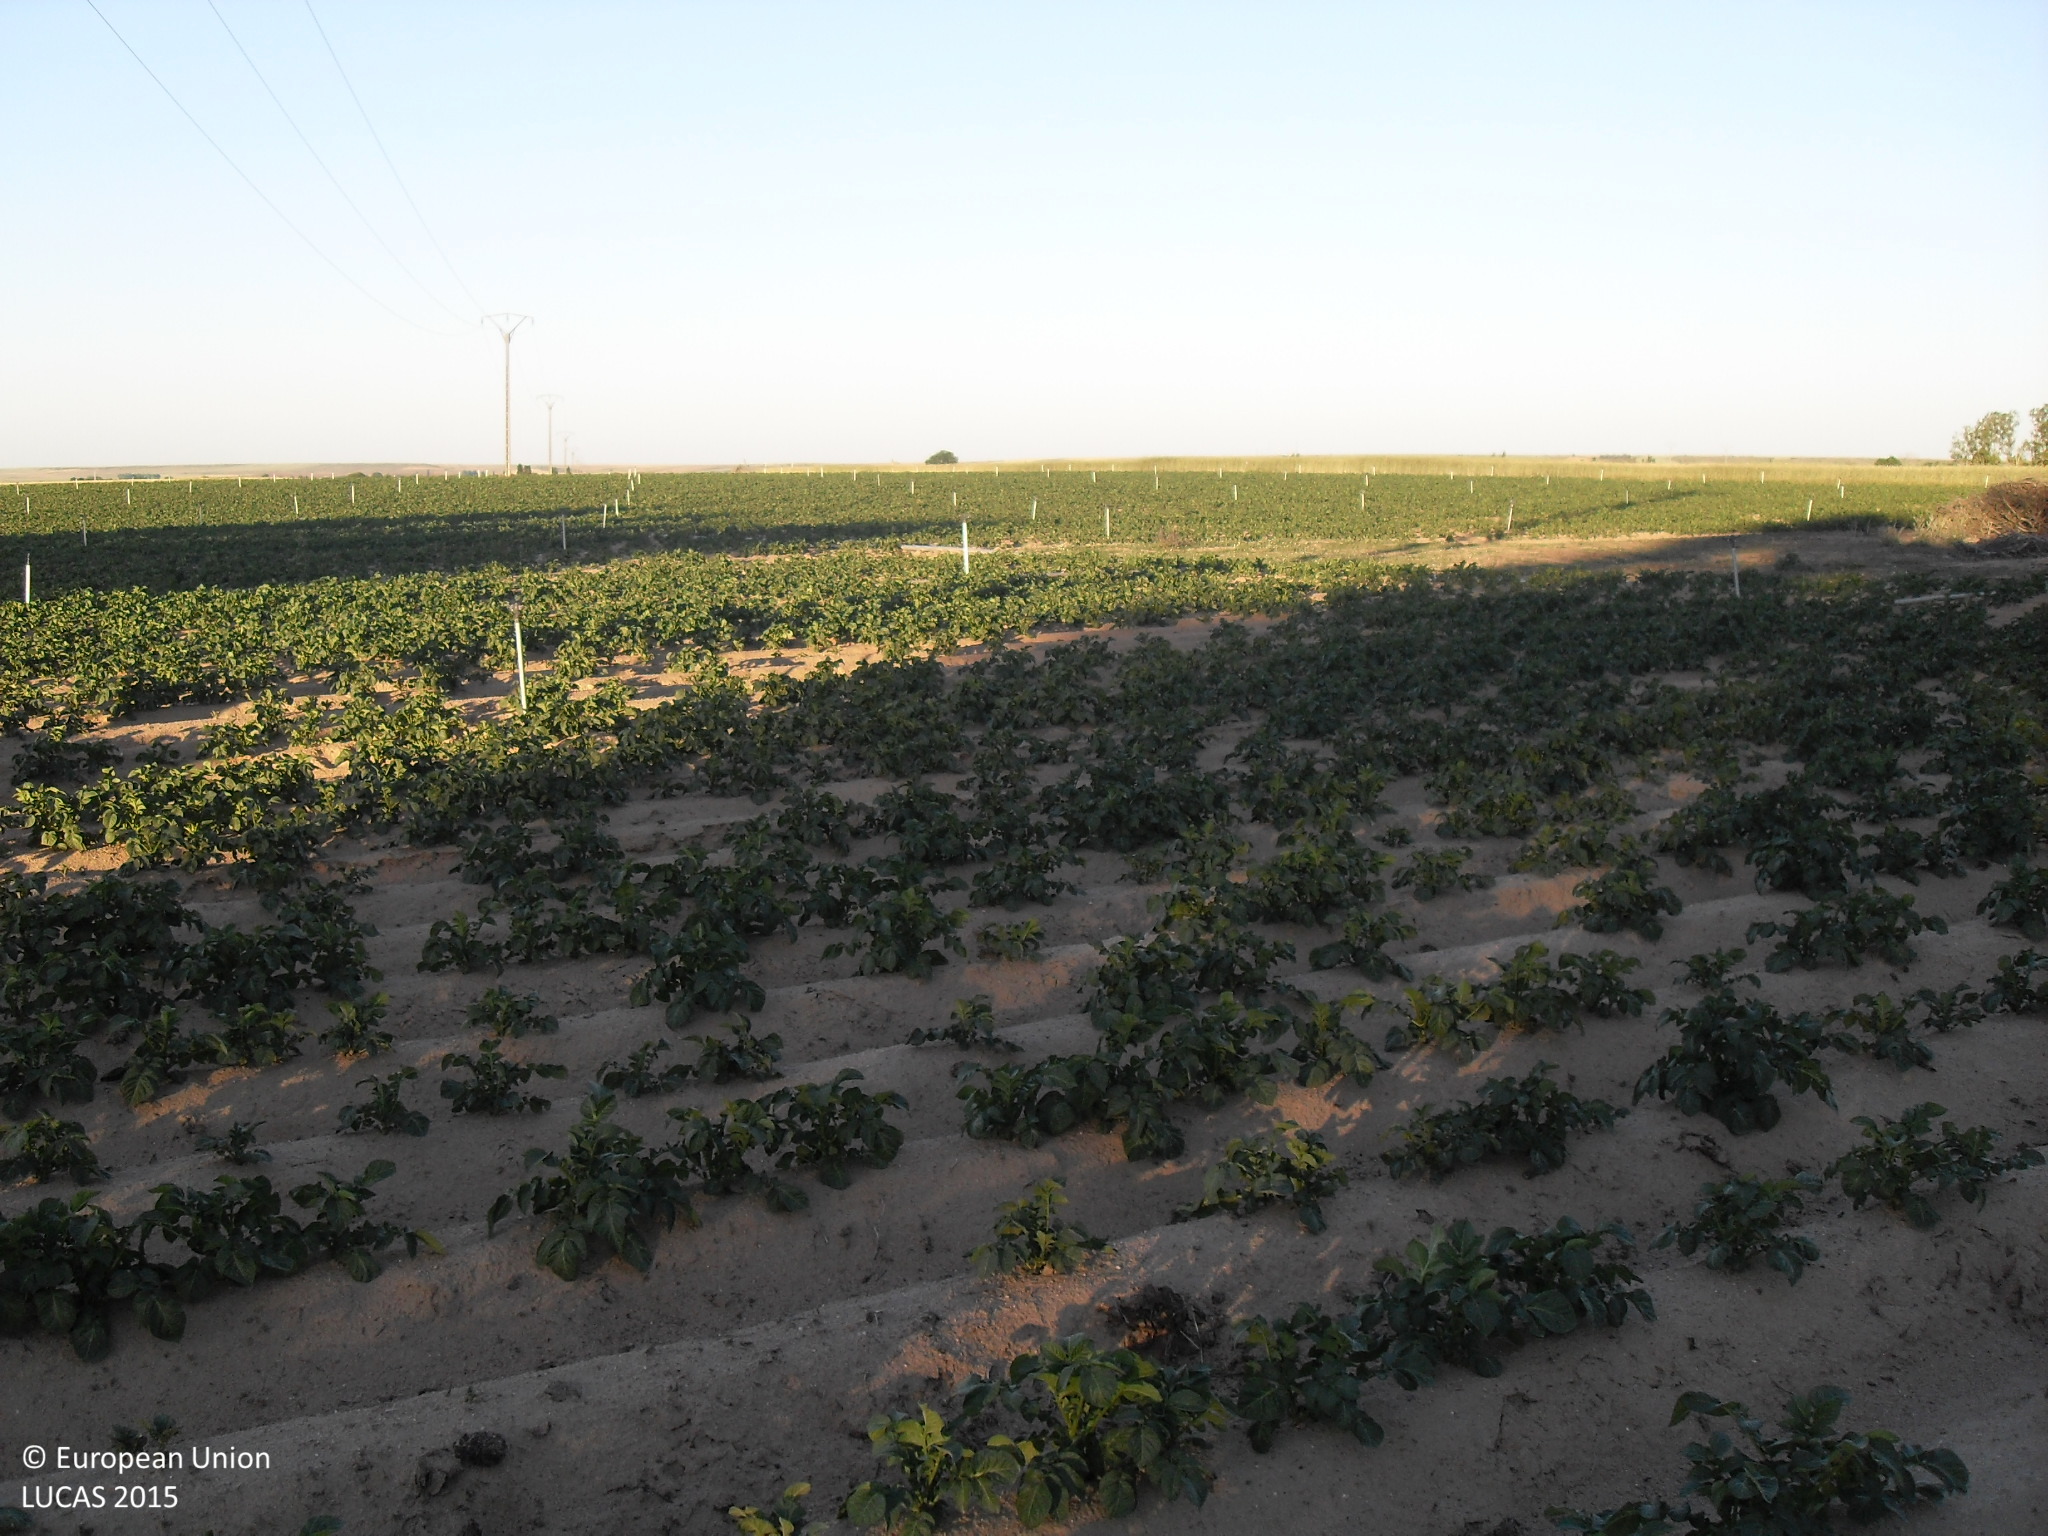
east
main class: Cropland
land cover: Potatoes
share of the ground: 25 - 50 %
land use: Agriculture (excluding fallow land and kitchen gardens)
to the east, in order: Potatoes; Rye
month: May
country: ES
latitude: 41.0519
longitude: -5.3614
